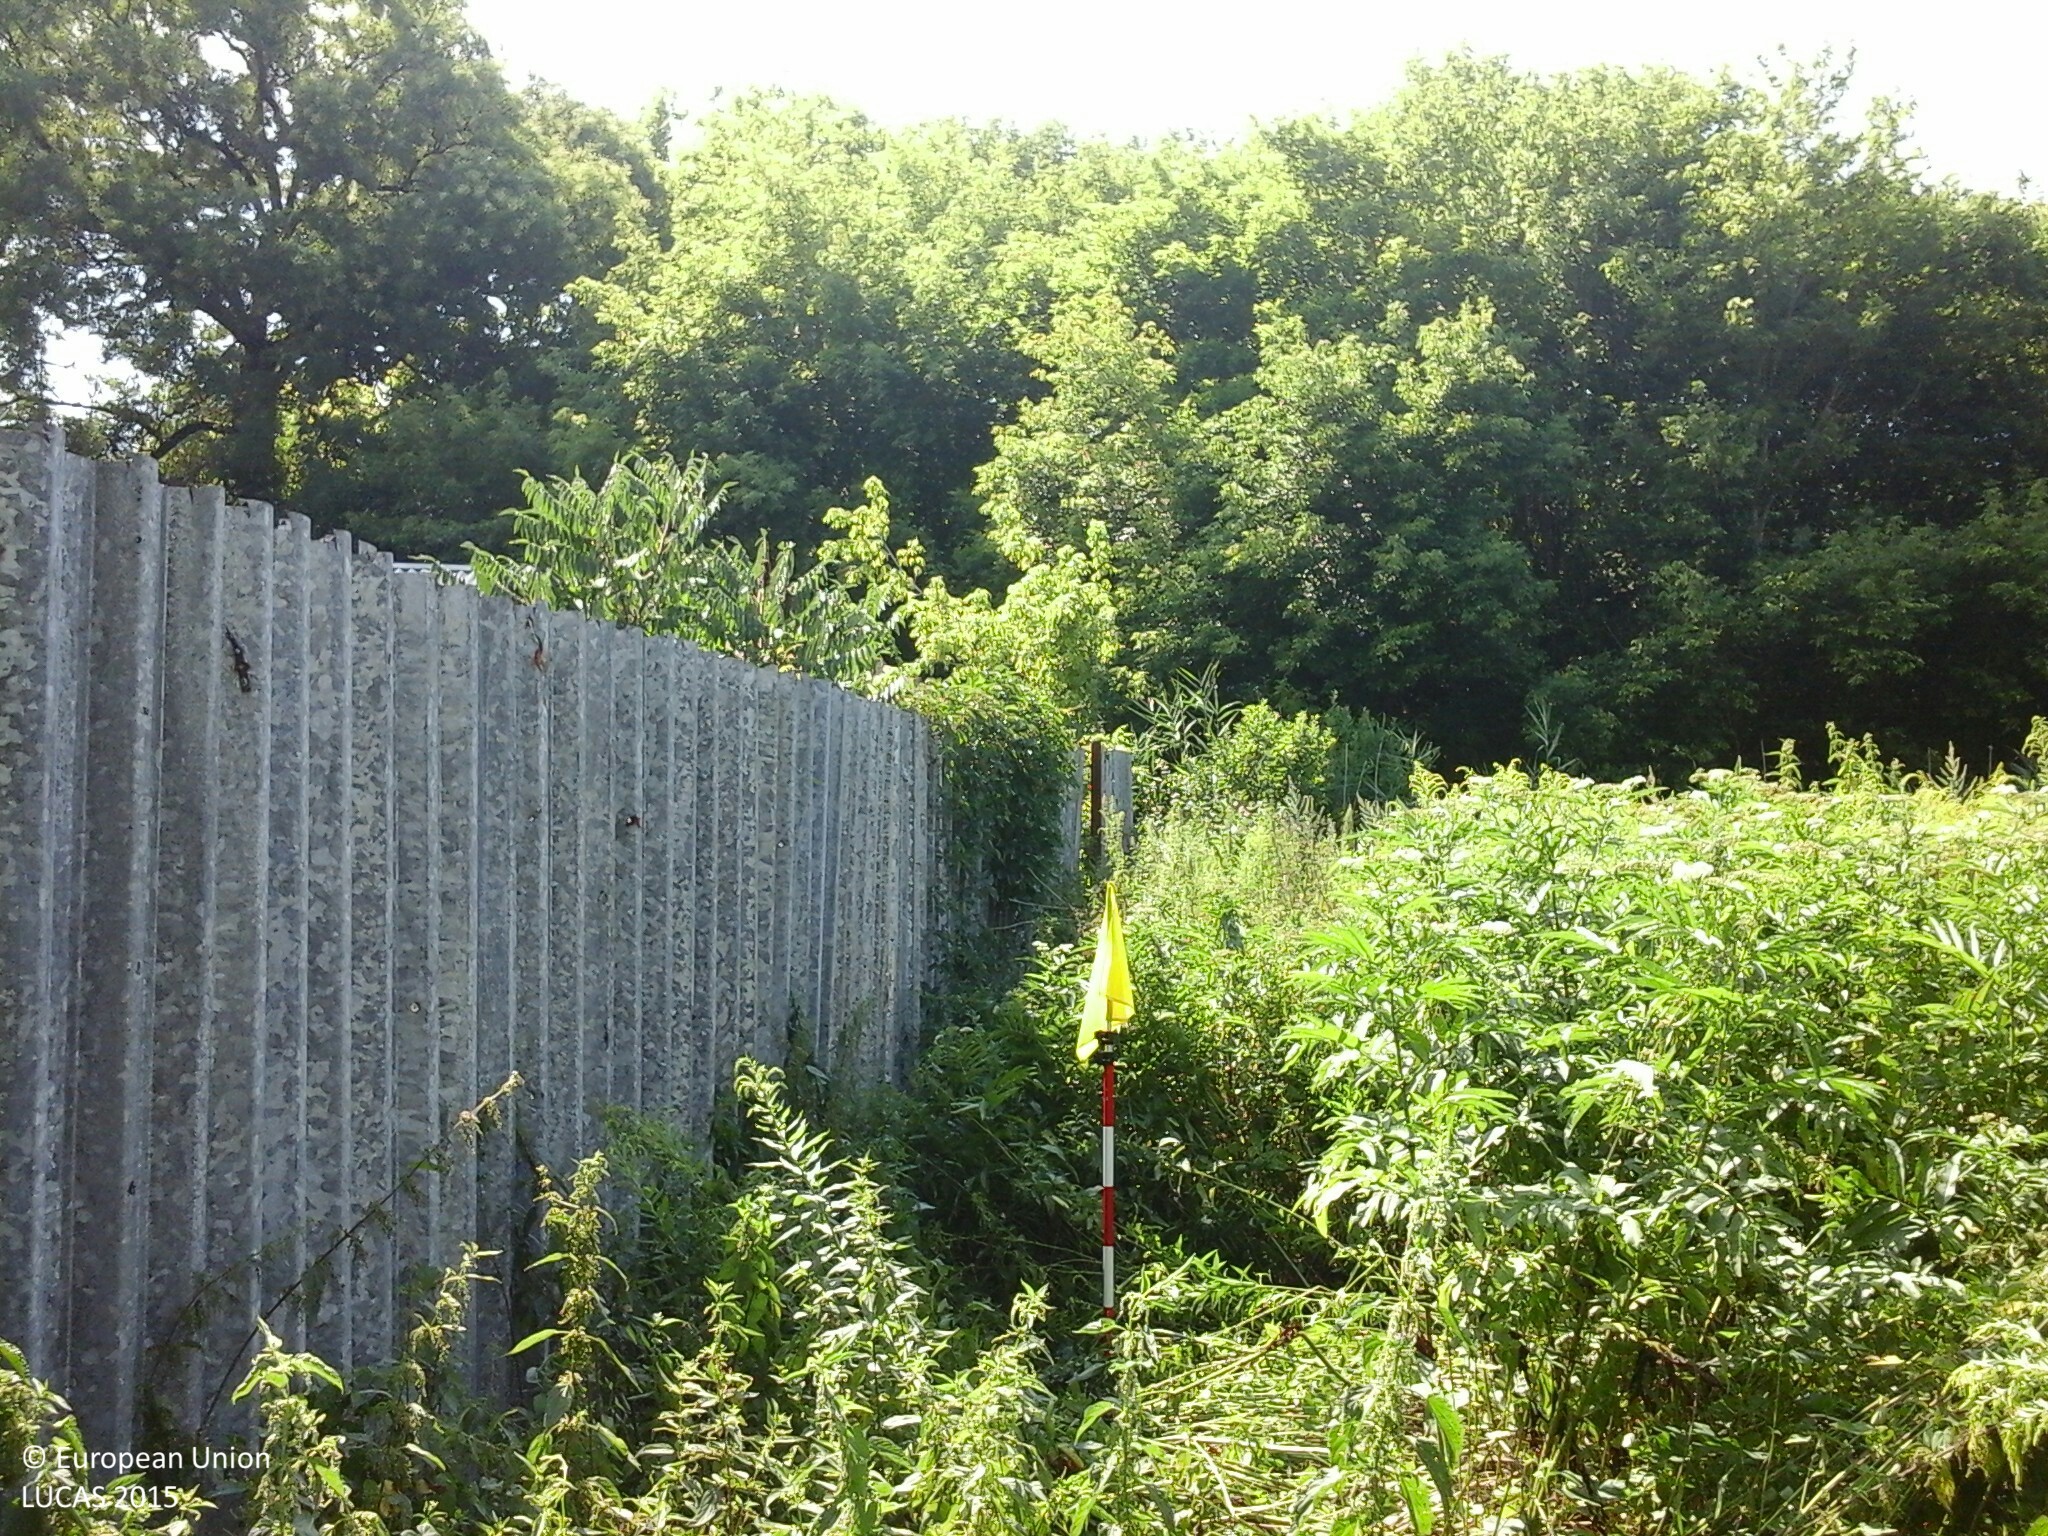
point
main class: Grassland
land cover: Grassland with sparse tree/shrub cover
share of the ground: > 75 %
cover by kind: herbaceous plants 95 %, broadleaved forest trees 5 %
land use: Semi-natural and natural areas not in use
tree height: < 5 m
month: August
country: HU
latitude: 48.1658
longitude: 20.3992
